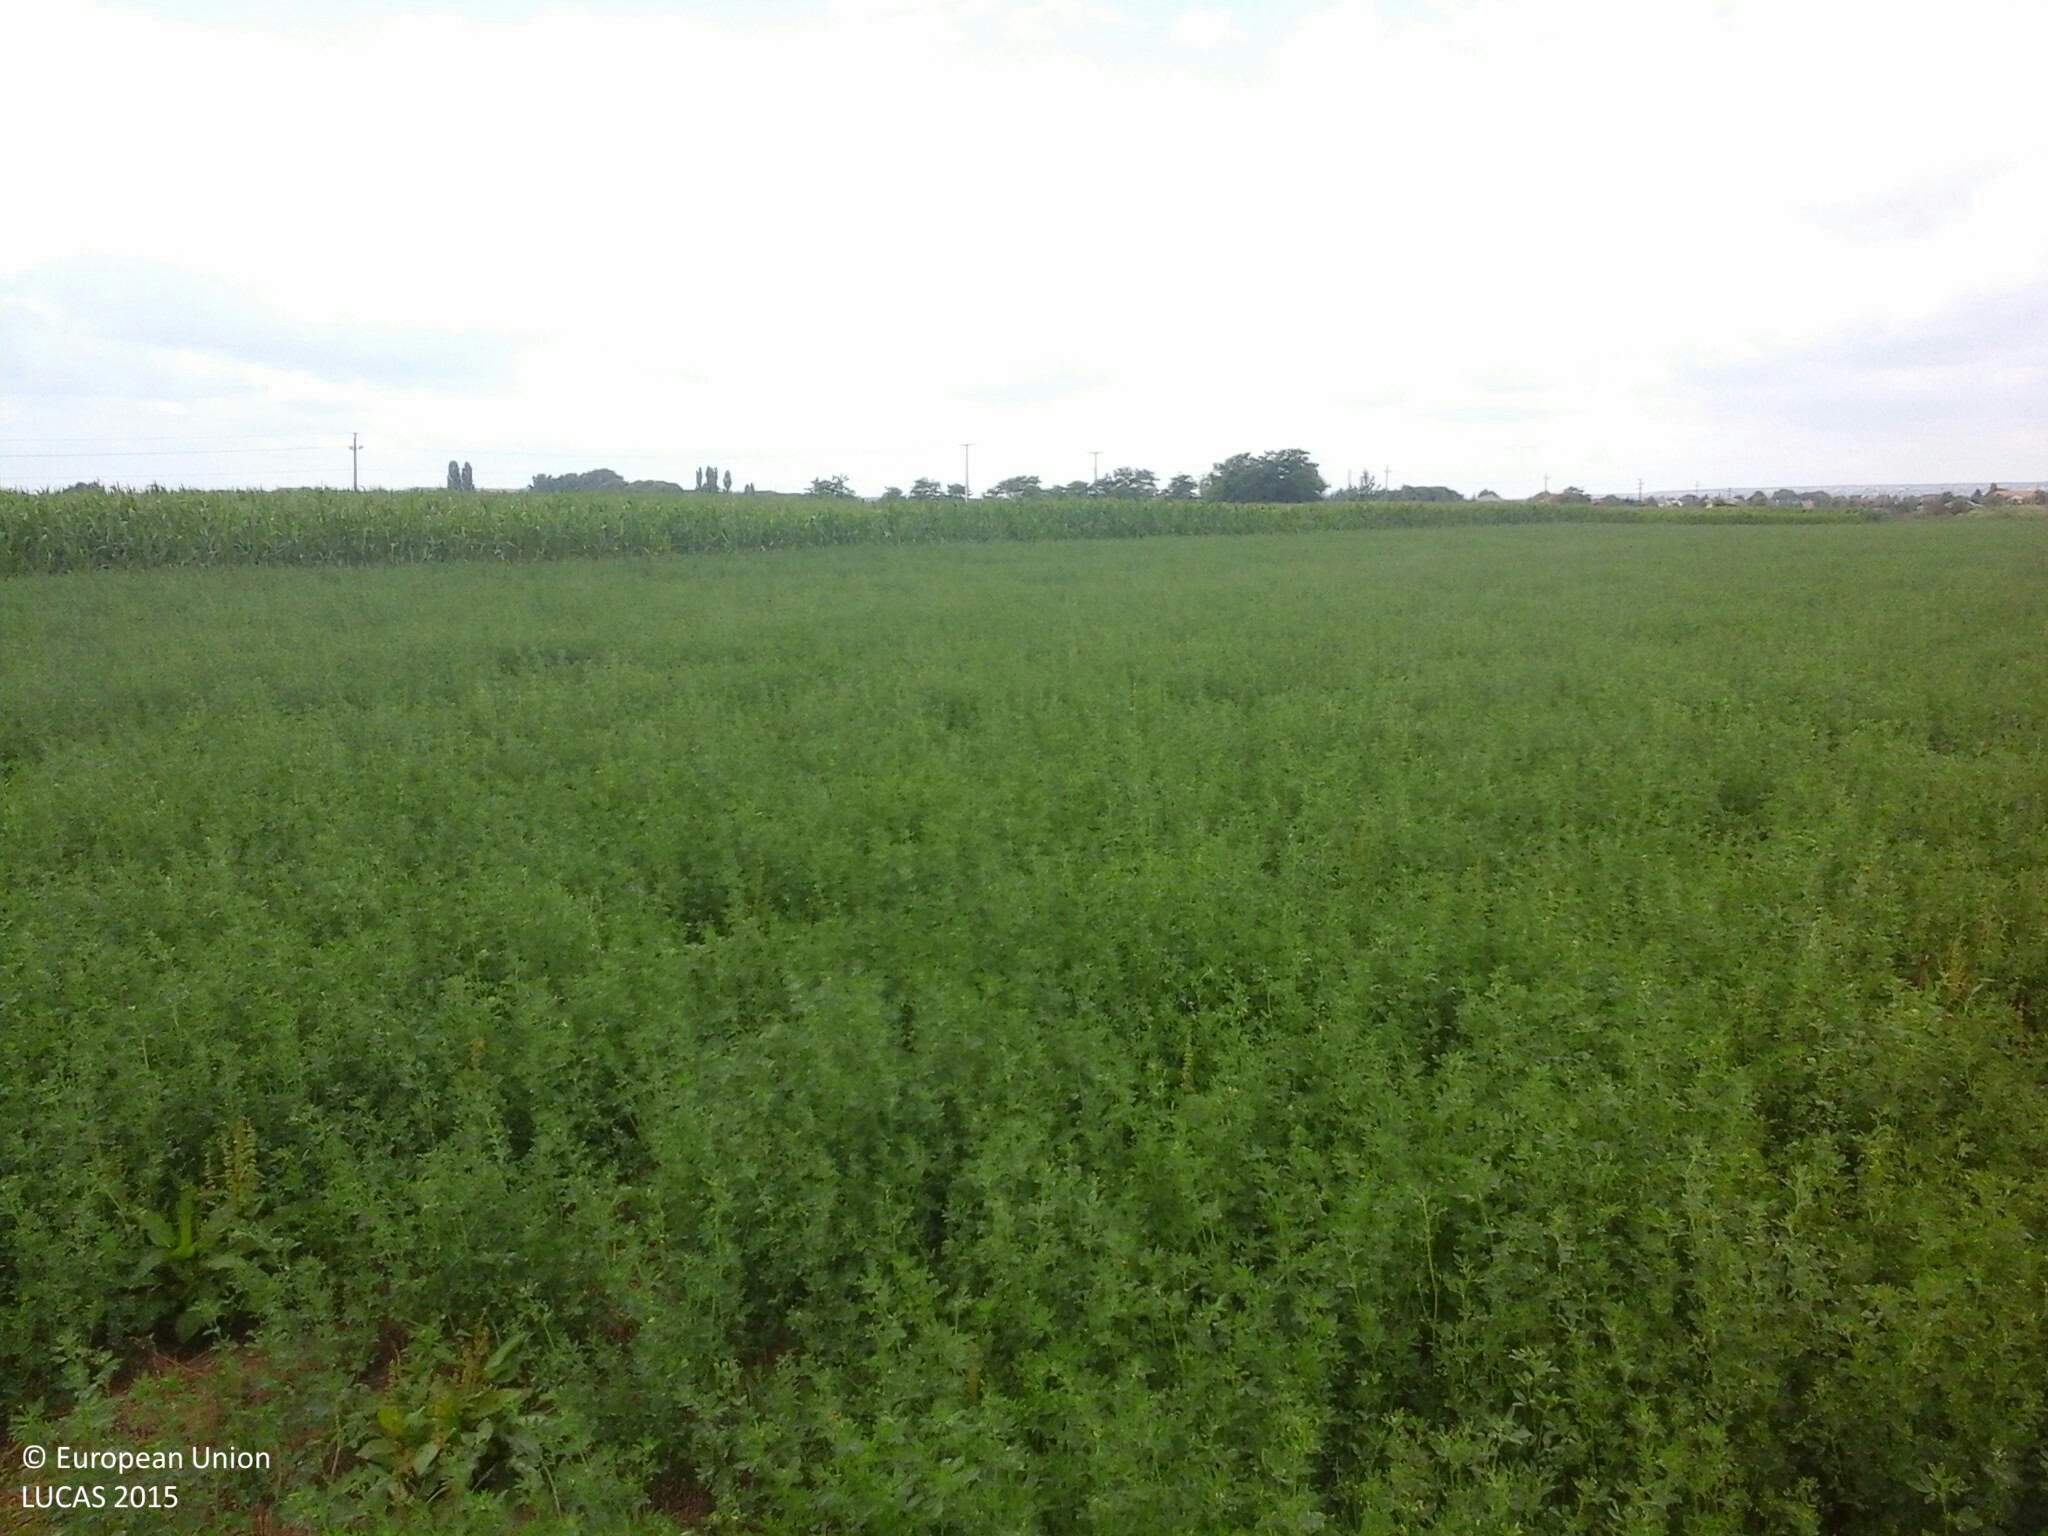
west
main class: Cropland
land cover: Lucerne
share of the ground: > 75 %
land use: Agriculture (excluding fallow land and kitchen gardens)
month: July
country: HU
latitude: 47.3474
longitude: 19.0048
